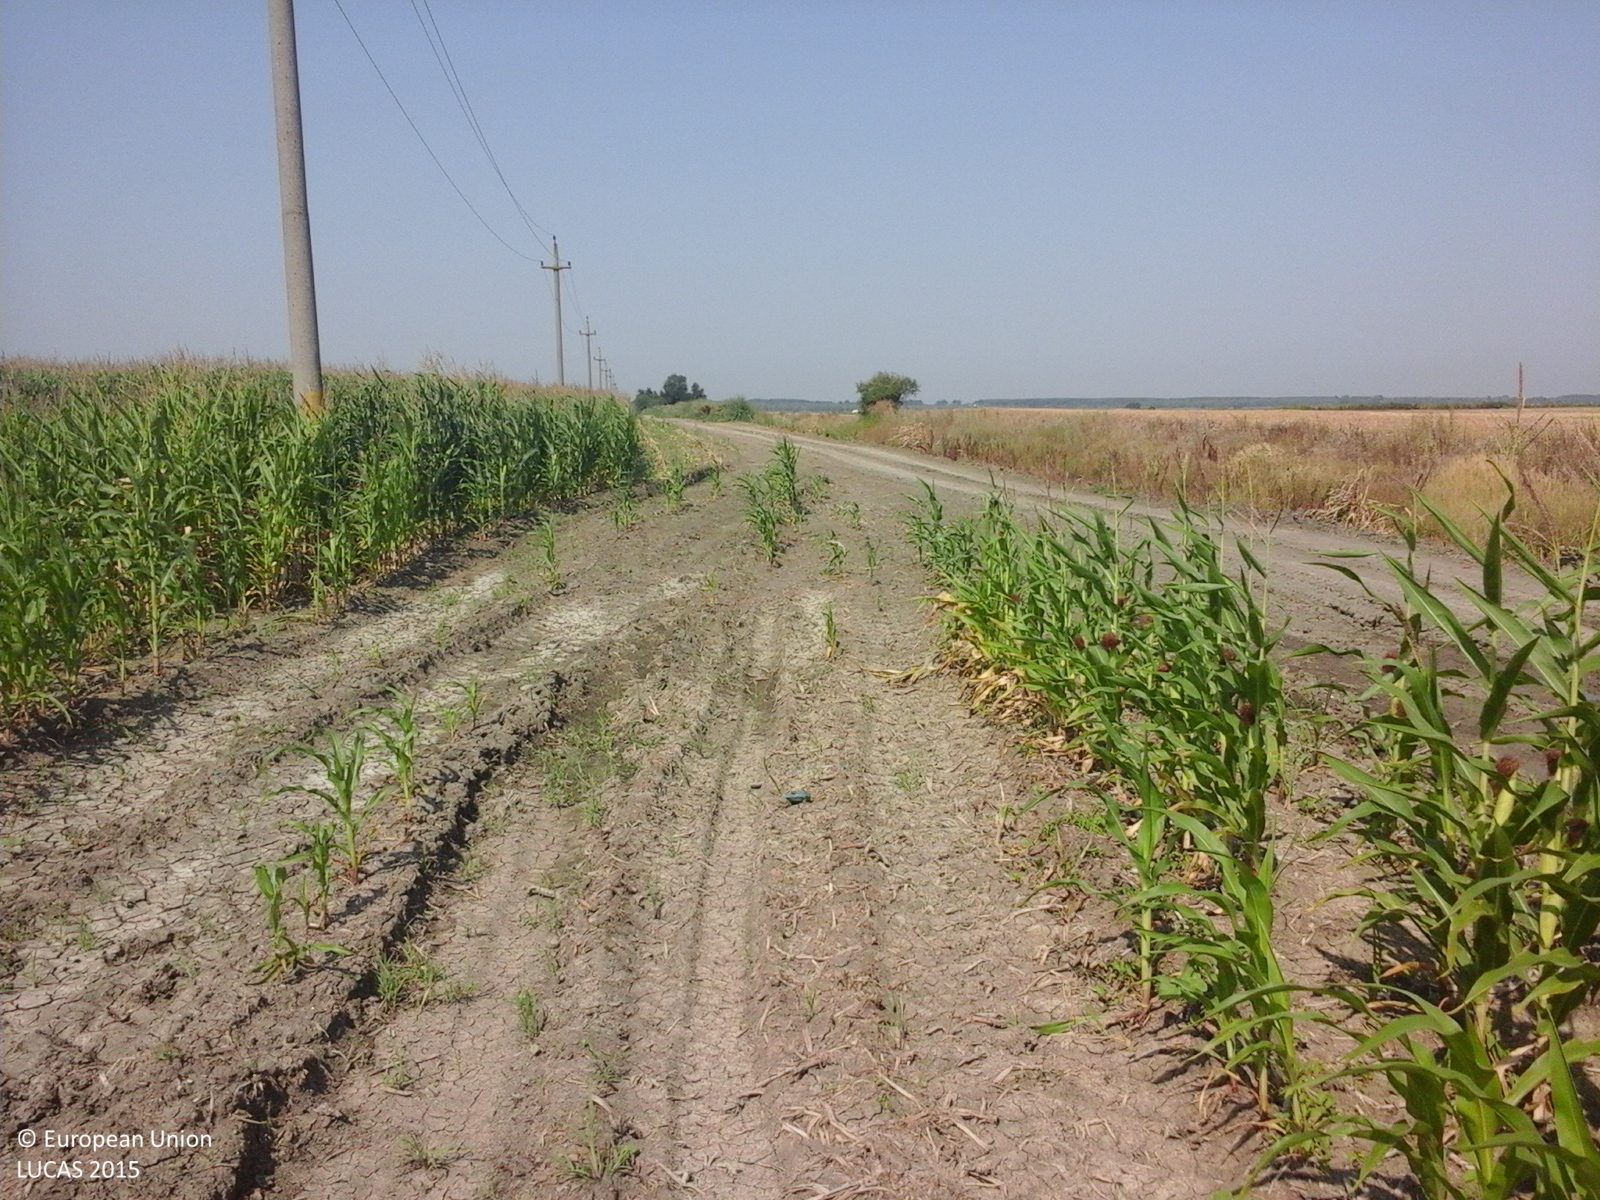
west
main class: Cropland
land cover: Maize
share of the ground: > 75 %
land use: Agriculture (excluding fallow land and kitchen gardens)
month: August
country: RO
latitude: 45.1690
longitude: 28.0430
